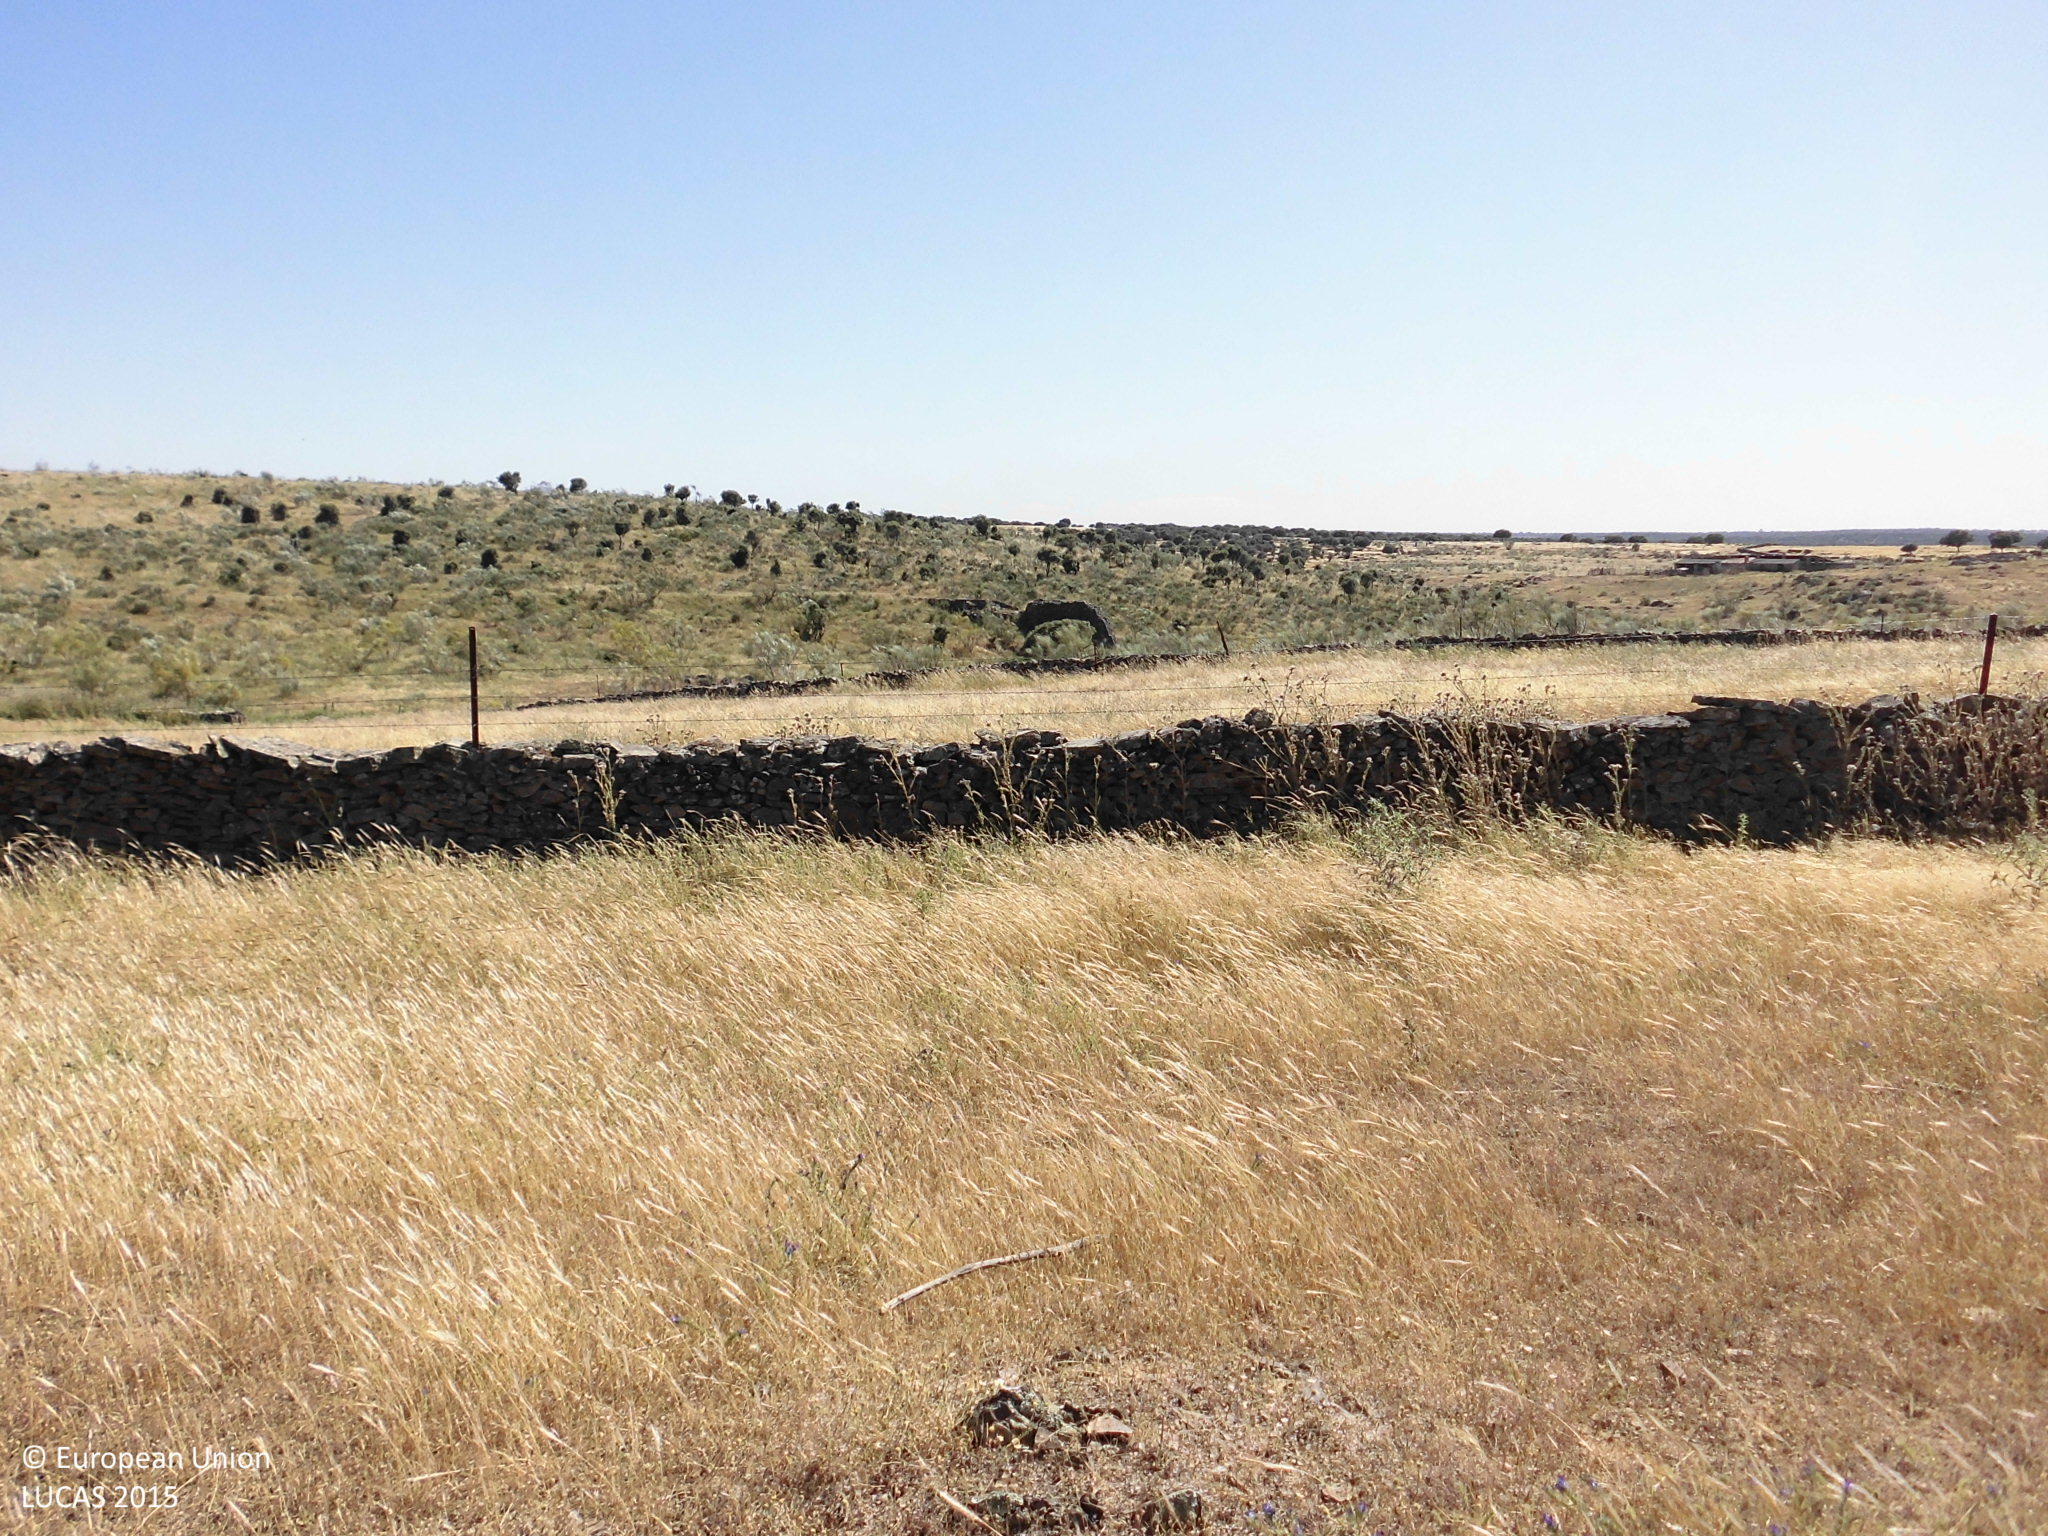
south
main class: Grassland
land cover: Grassland without tree/shrub cover
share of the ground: > 75 %
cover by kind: herbaceous plants 100 %
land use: Agriculture (excluding fallow land and kitchen gardens)
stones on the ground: 10 - 25 %
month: May
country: ES
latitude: 39.3750
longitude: -6.0680
